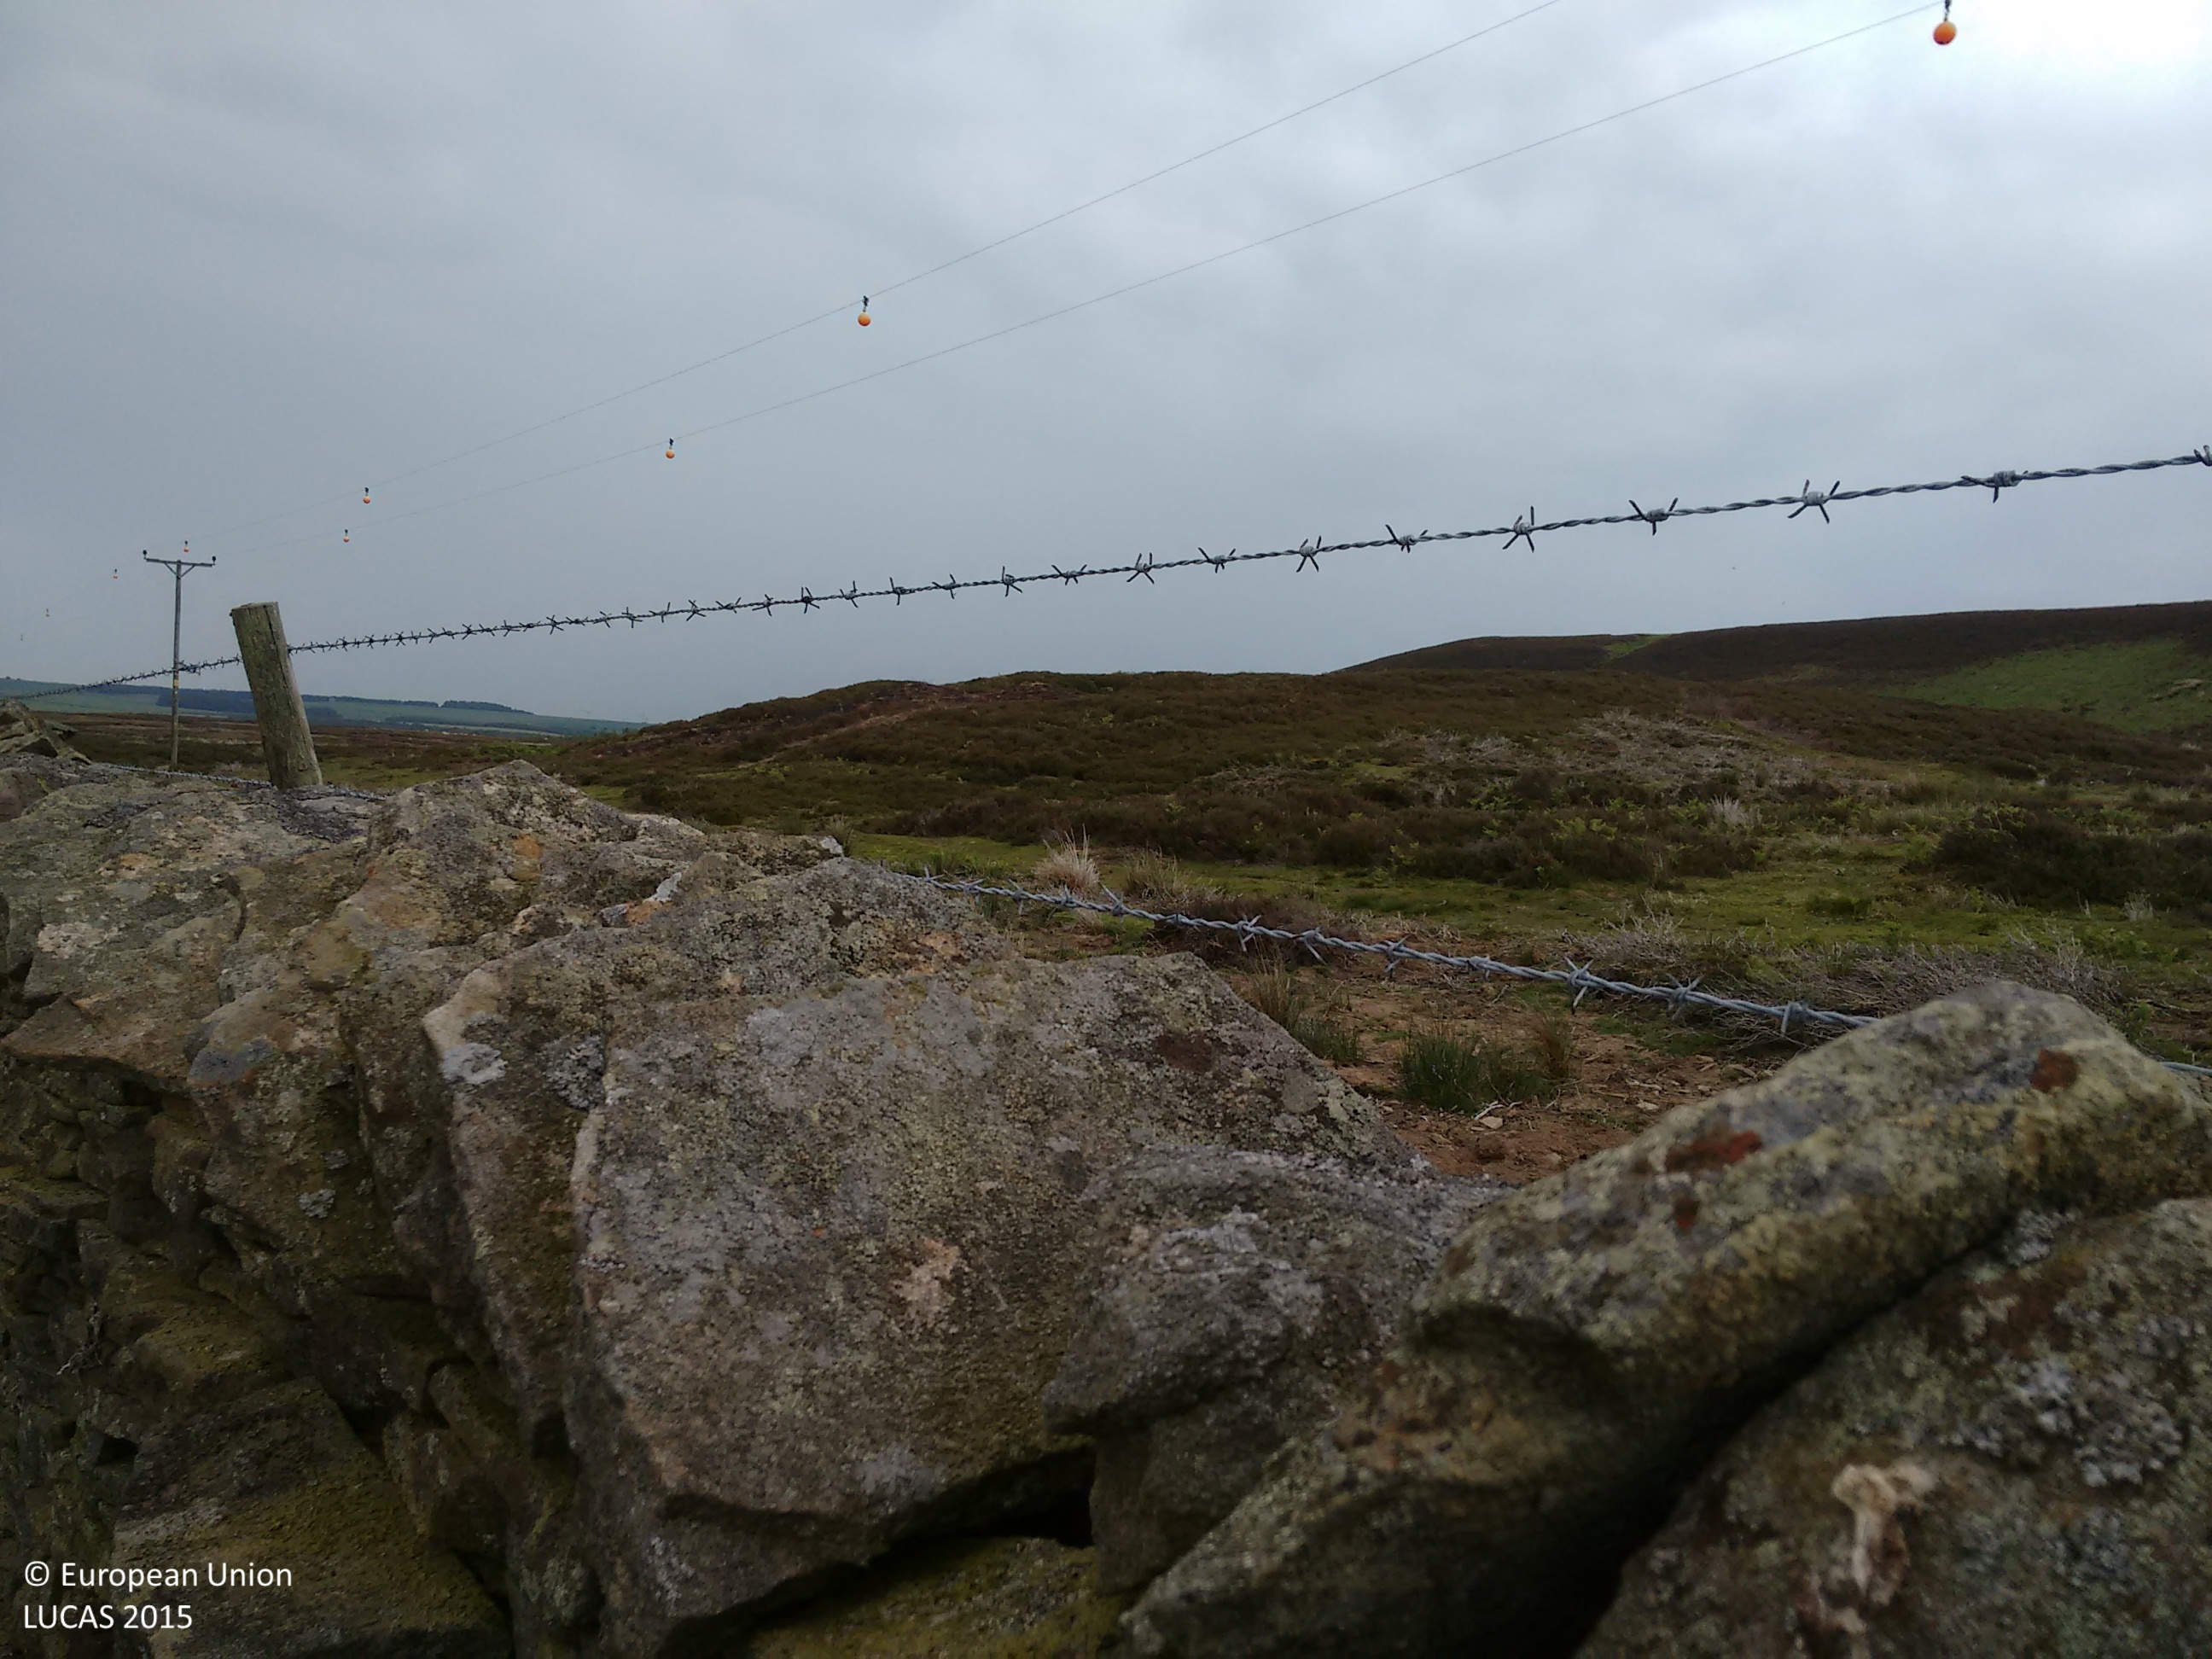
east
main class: Shrubland
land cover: Shrubland without tree cover
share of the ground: > 75 %
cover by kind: shrubs 90 %, herbaceous plants 10 %
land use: Agriculture (excluding fallow land and kitchen gardens)
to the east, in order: Shrubland without tree cover; Ditches and canals; Shrubland without tree cover
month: June
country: GB
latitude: 54.8576
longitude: -2.0032
